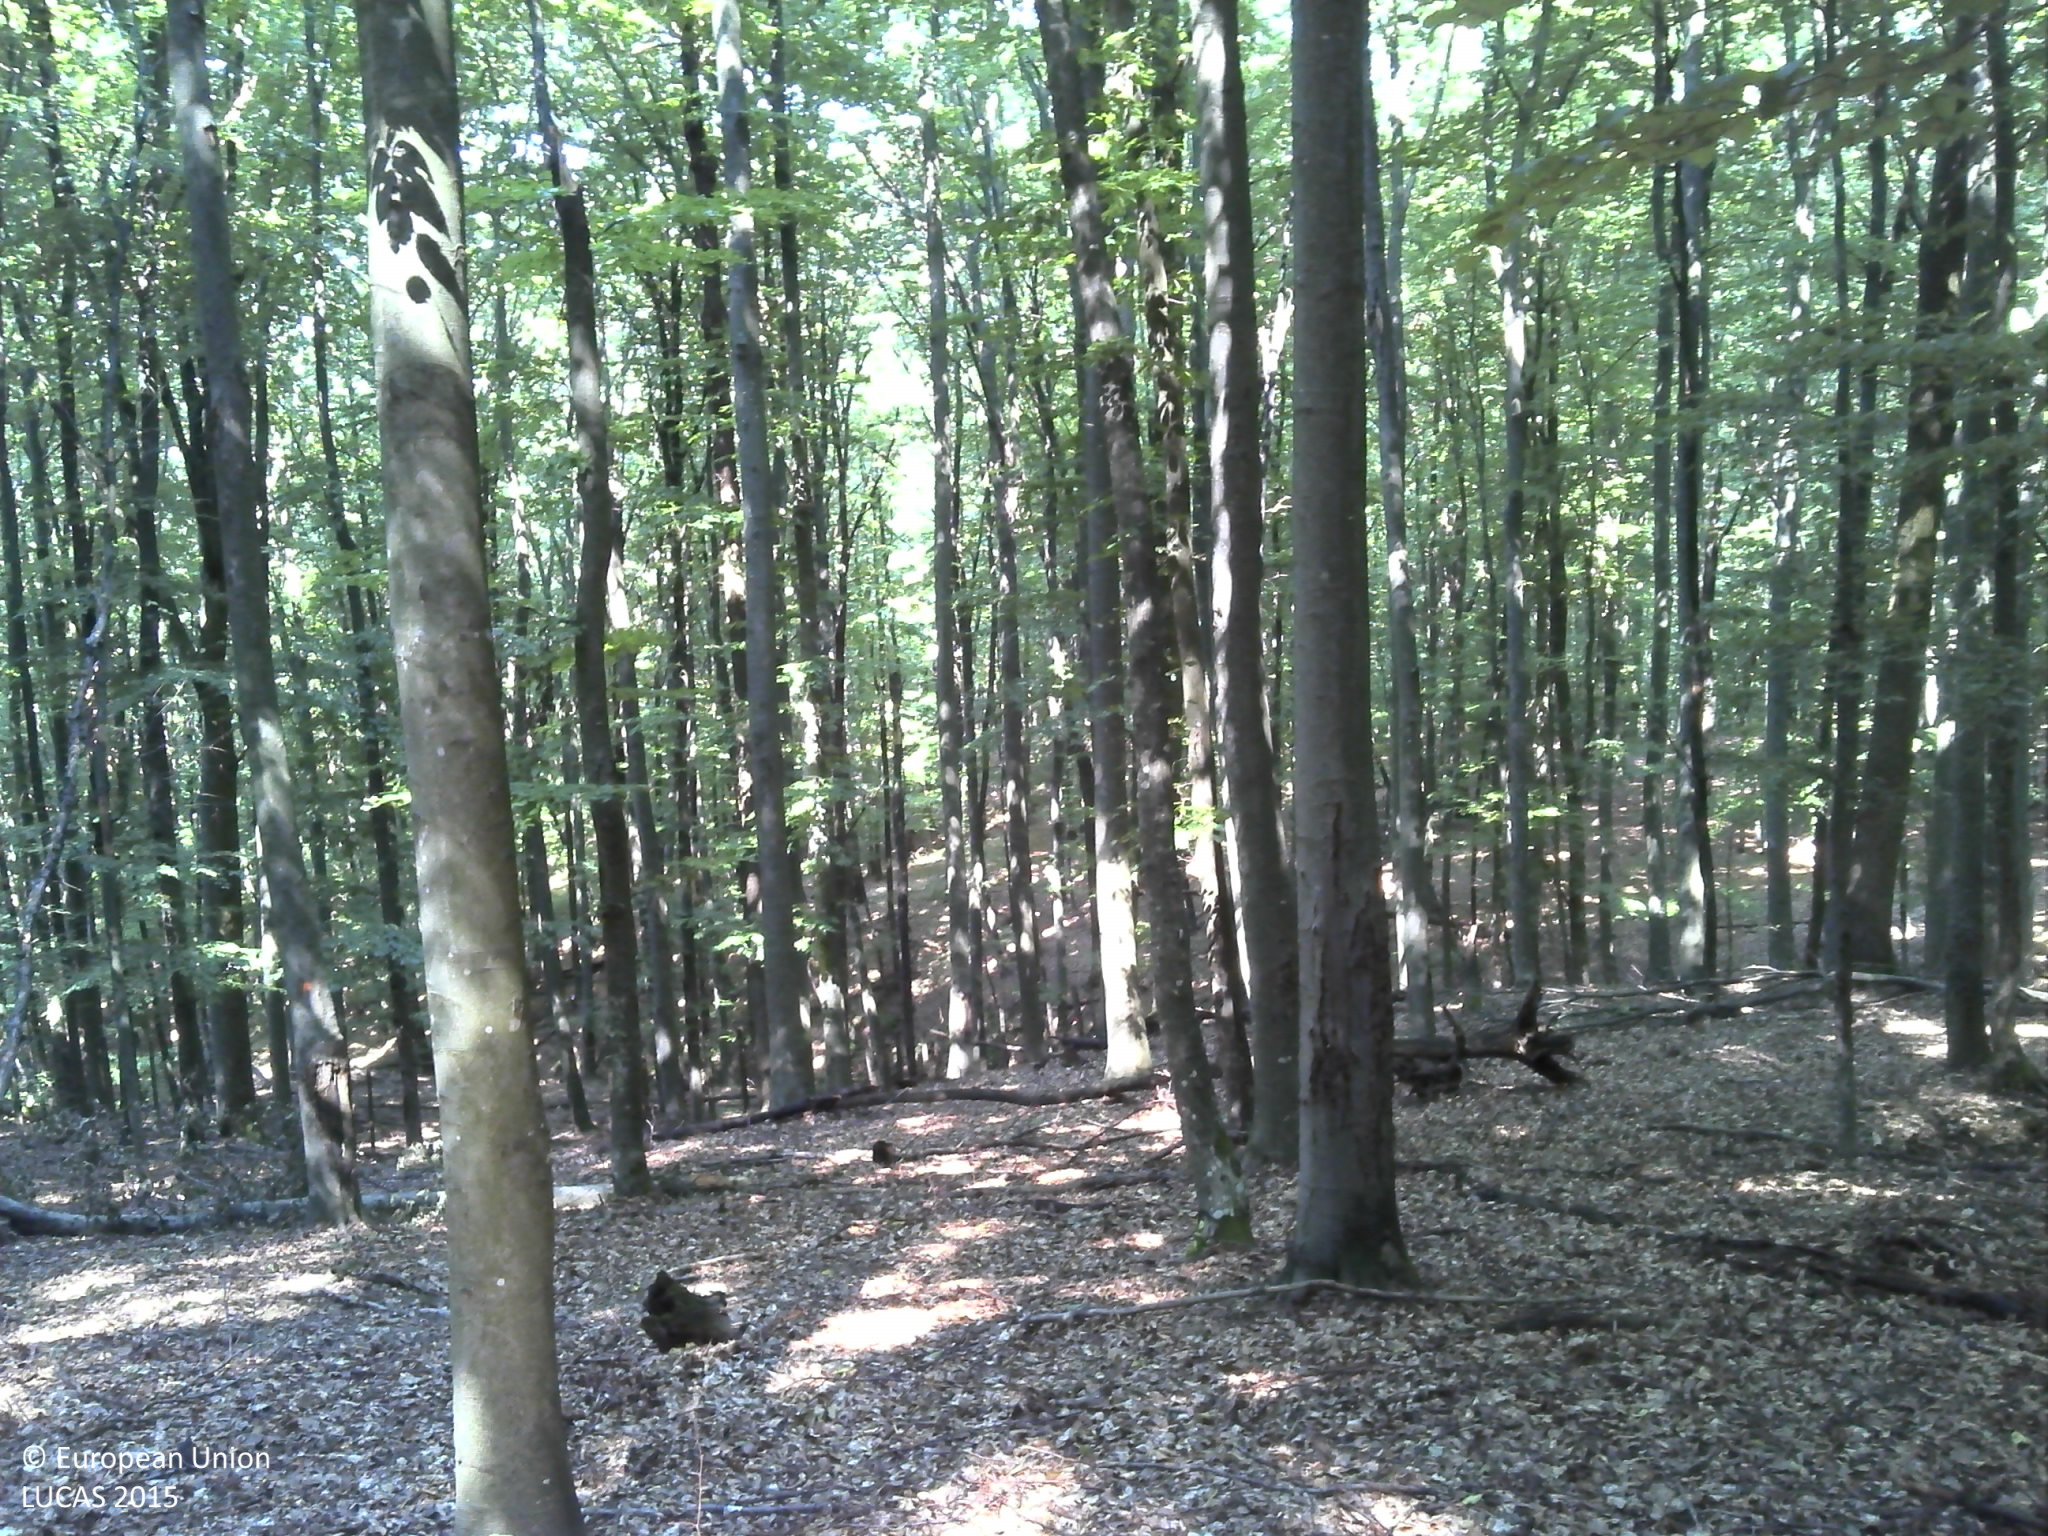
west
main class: Woodland
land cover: Broadleaved woodland
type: acidophilous oak and oak-birch forest
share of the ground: > 75 %
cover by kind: broadleaved forest trees 80 %, lichens and mosses 20 %
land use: Forestry
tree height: > 5 m
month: July
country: HR
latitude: 45.5790
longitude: 16.7273
